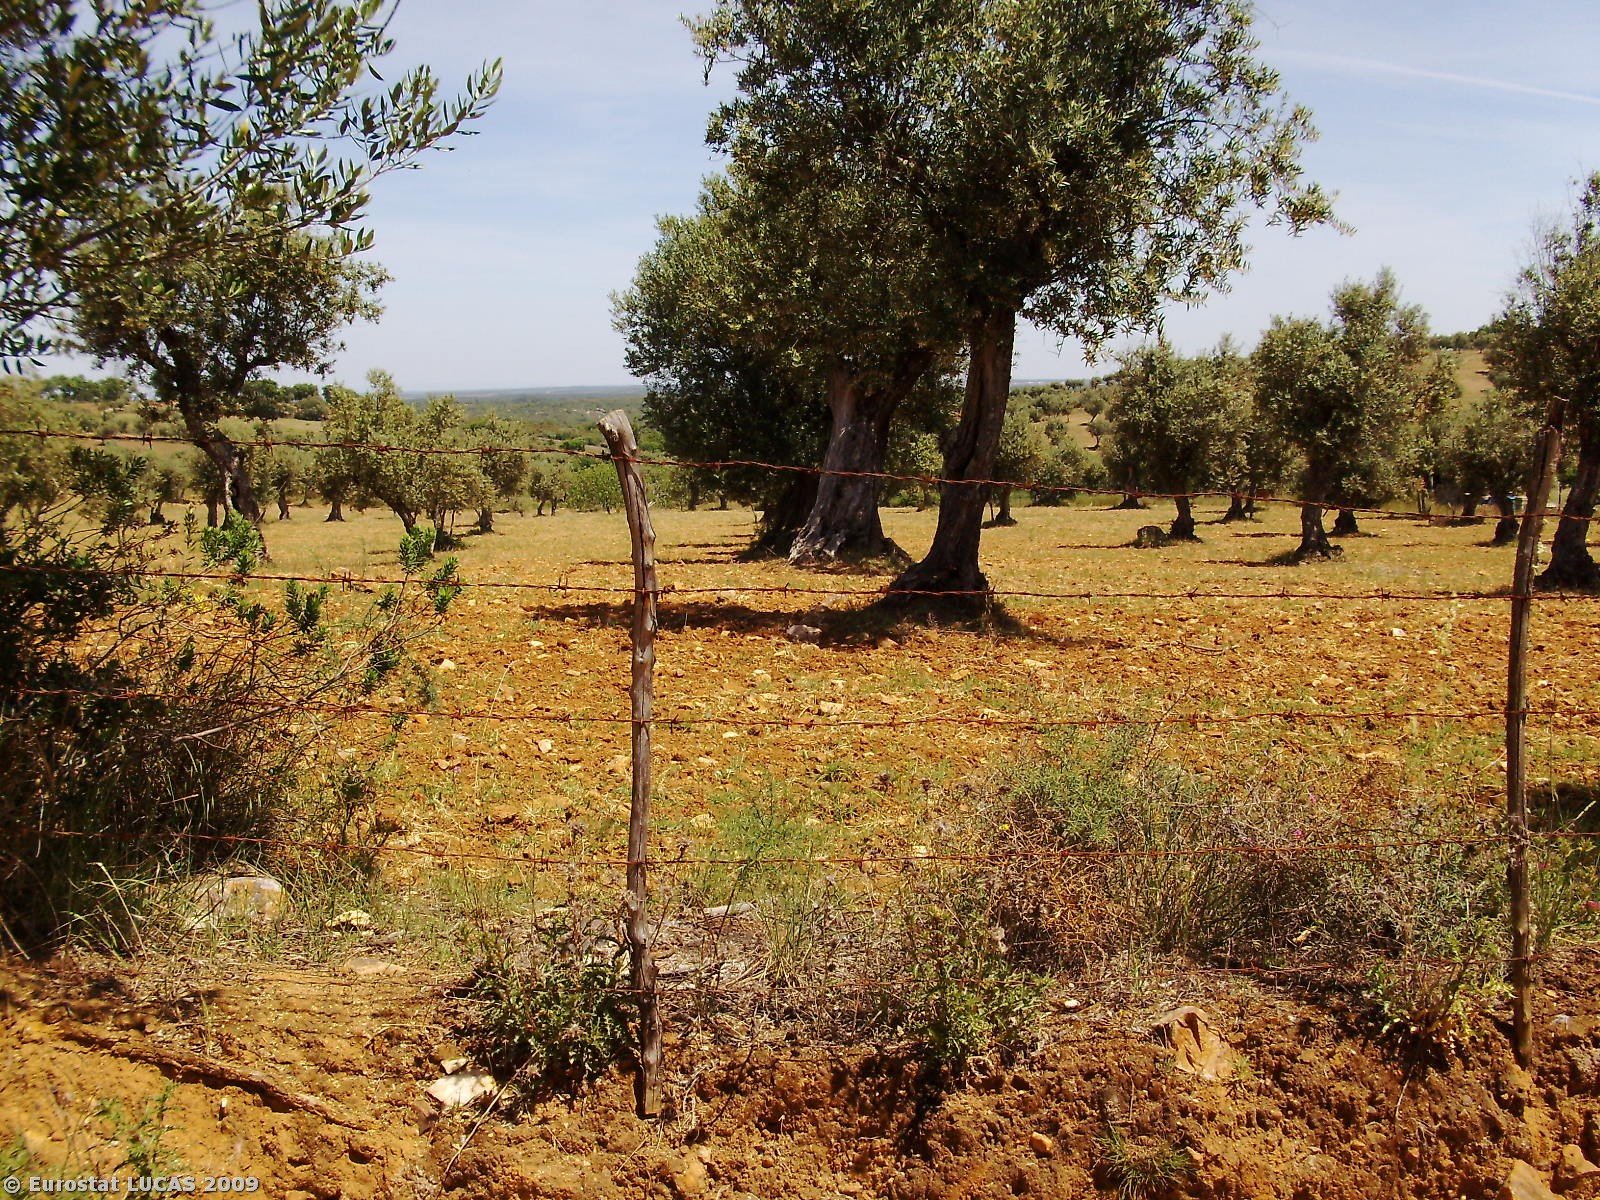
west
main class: Cropland
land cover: Olive groves
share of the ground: 50 - 75 %
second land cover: Bare land
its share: 25 - 50 %
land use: Agriculture (excluding fallow land and kitchen gardens)
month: May
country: PT
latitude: 39.1638
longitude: -7.9797
